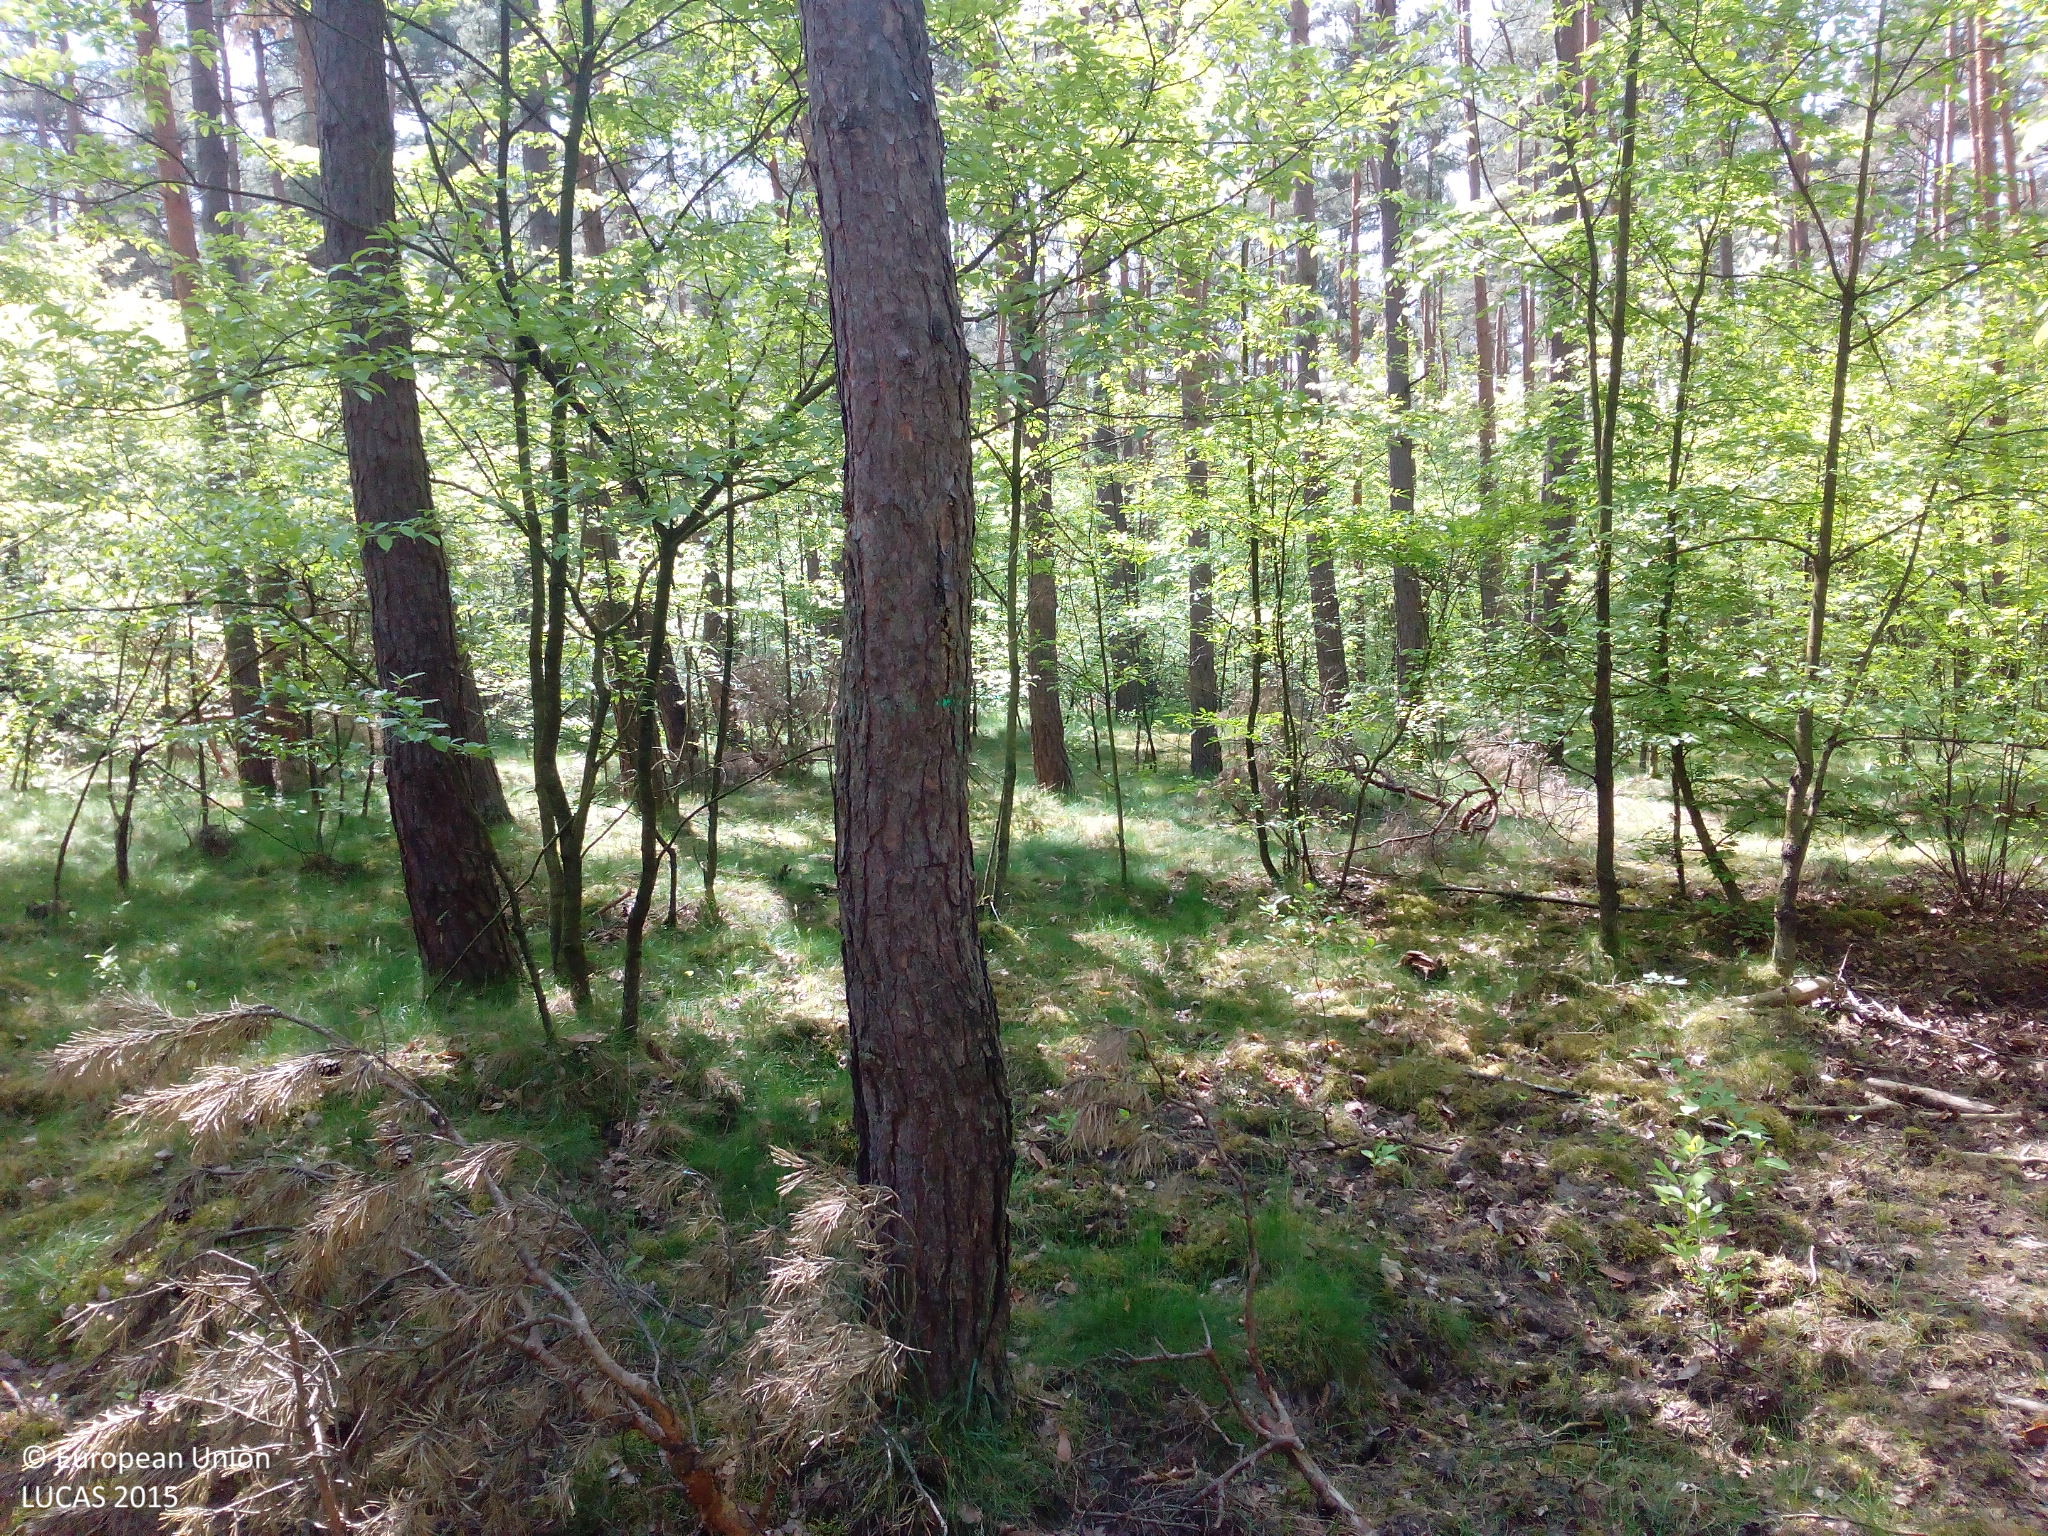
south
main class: Woodland
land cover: Pine dominated mixed woodland
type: hemiboreal forest and nemoral coniferous forest and mixed broadleaved-coniferous forest
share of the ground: 50 - 75 %
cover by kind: coniferous forest trees 40 %, broadleaved forest trees 25 %, herbaceous plants 20 %, unconsolidated bare surface 10 %, shrubs 5 %
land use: Forestry
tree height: > 5 m
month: May
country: DE
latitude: 49.5811
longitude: 8.5205
